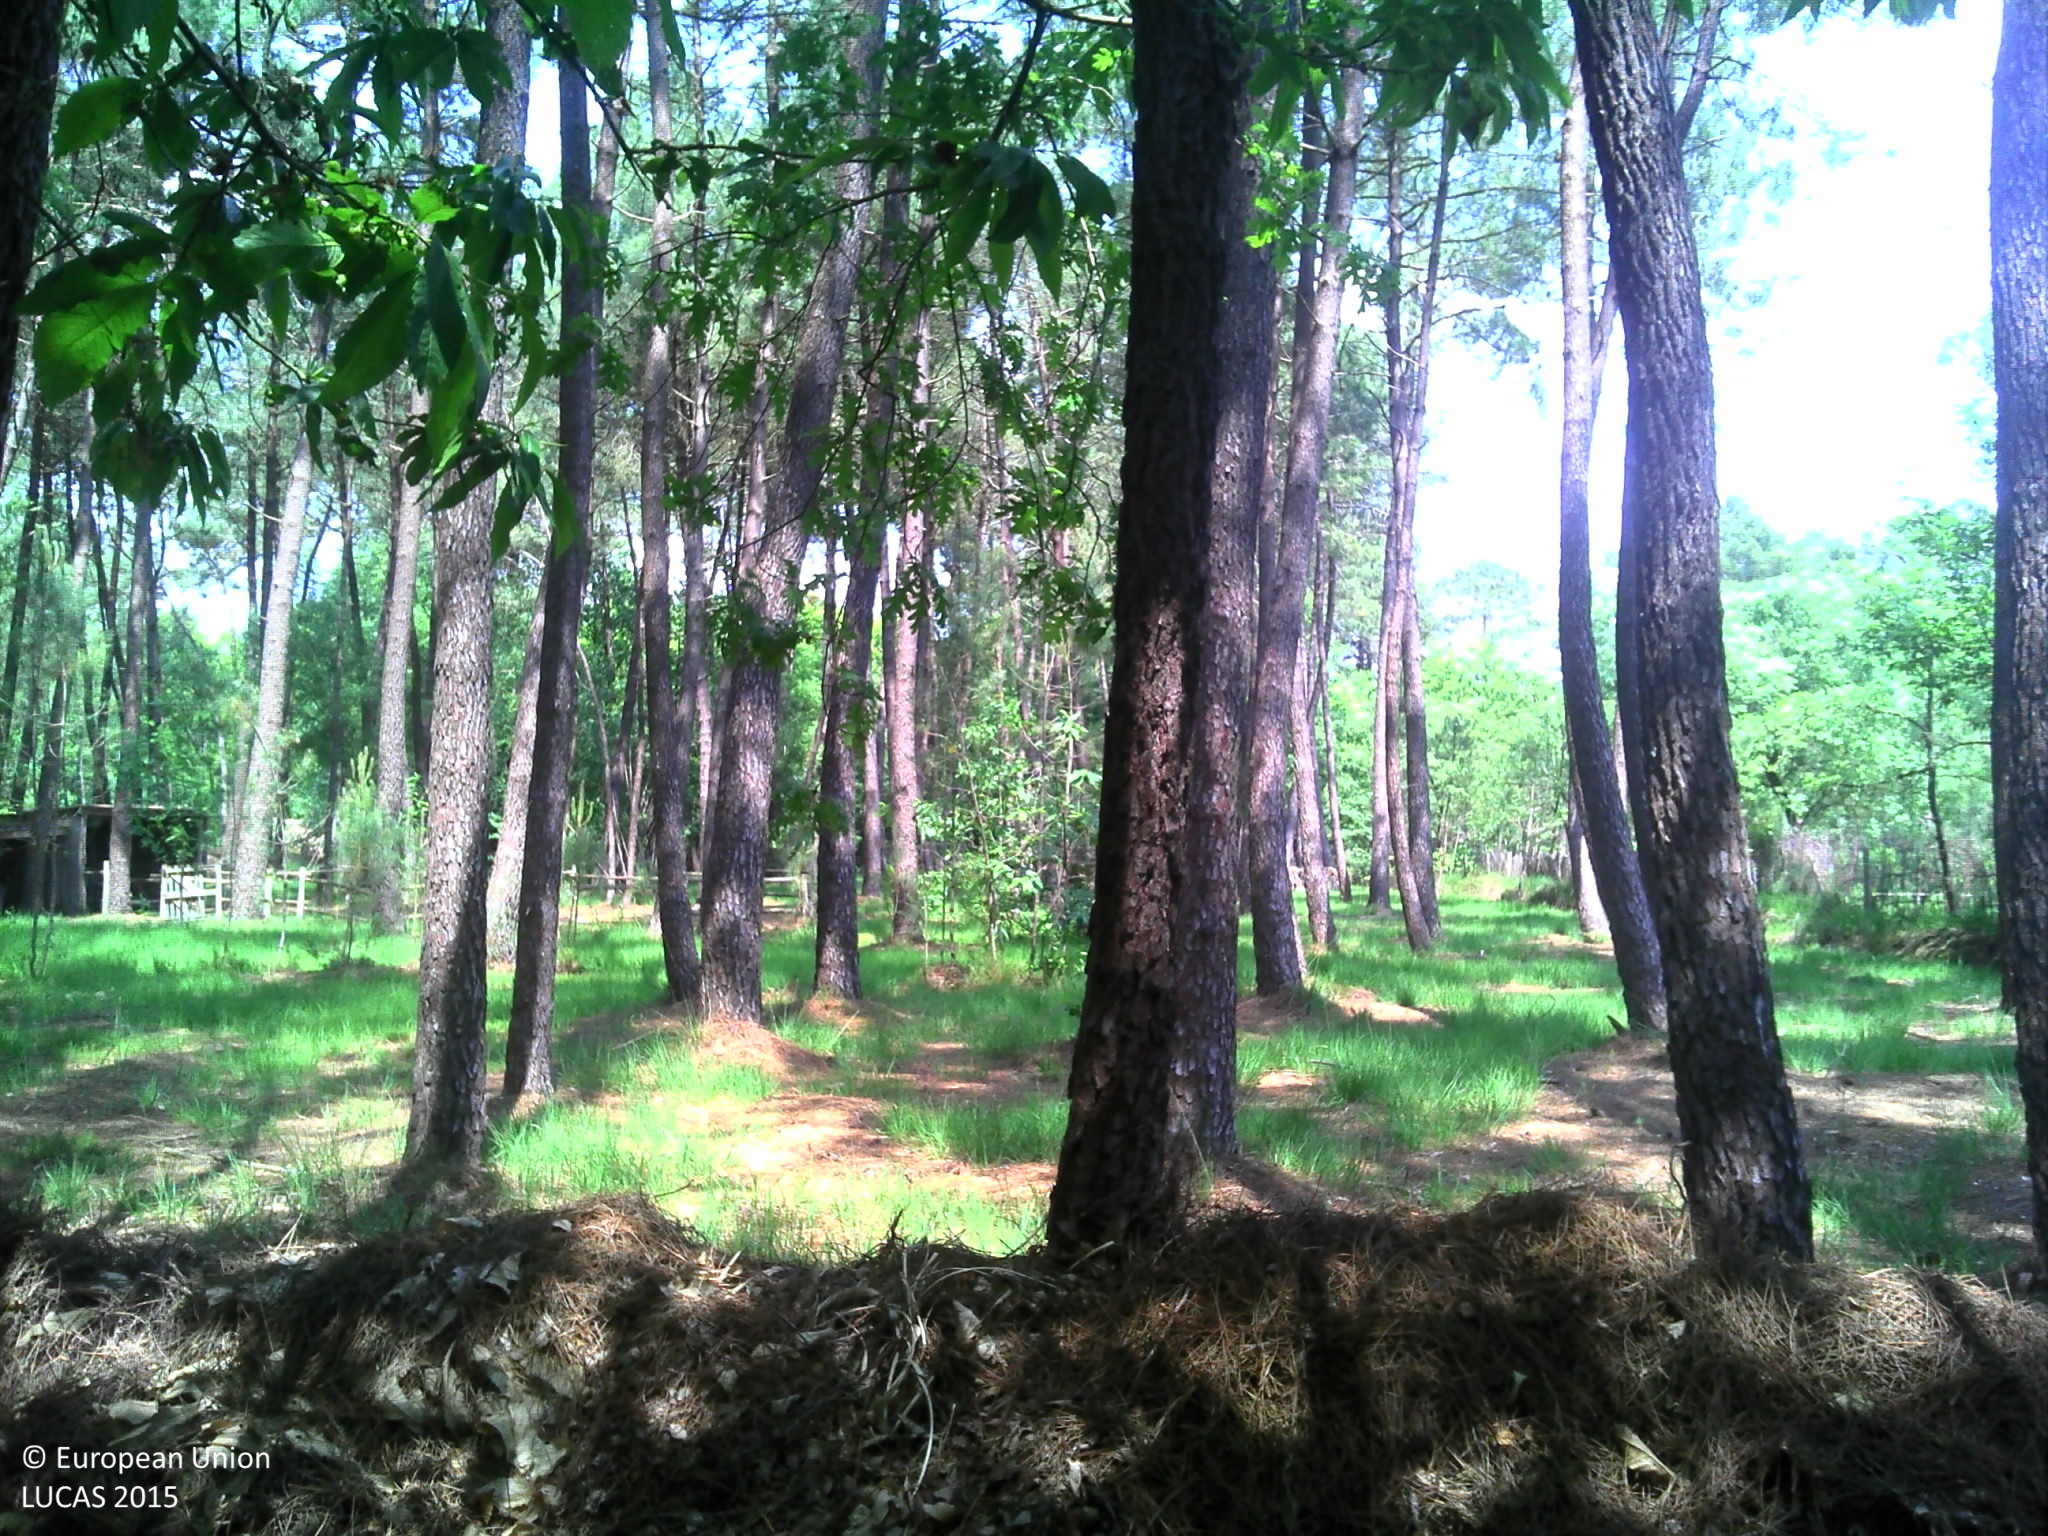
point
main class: Woodland
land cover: Pine dominated coniferous woodland
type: hemiboreal forest and nemoral coniferous forest and mixed broadleaved-coniferous forest
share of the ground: > 75 %
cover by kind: coniferous forest trees 75 %, shrubs 10 %, herbaceous plants 10 %, broadleaved forest trees 5 %
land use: Forestry
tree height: > 5 m
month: June
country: FR
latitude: 47.8063
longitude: 0.0252
